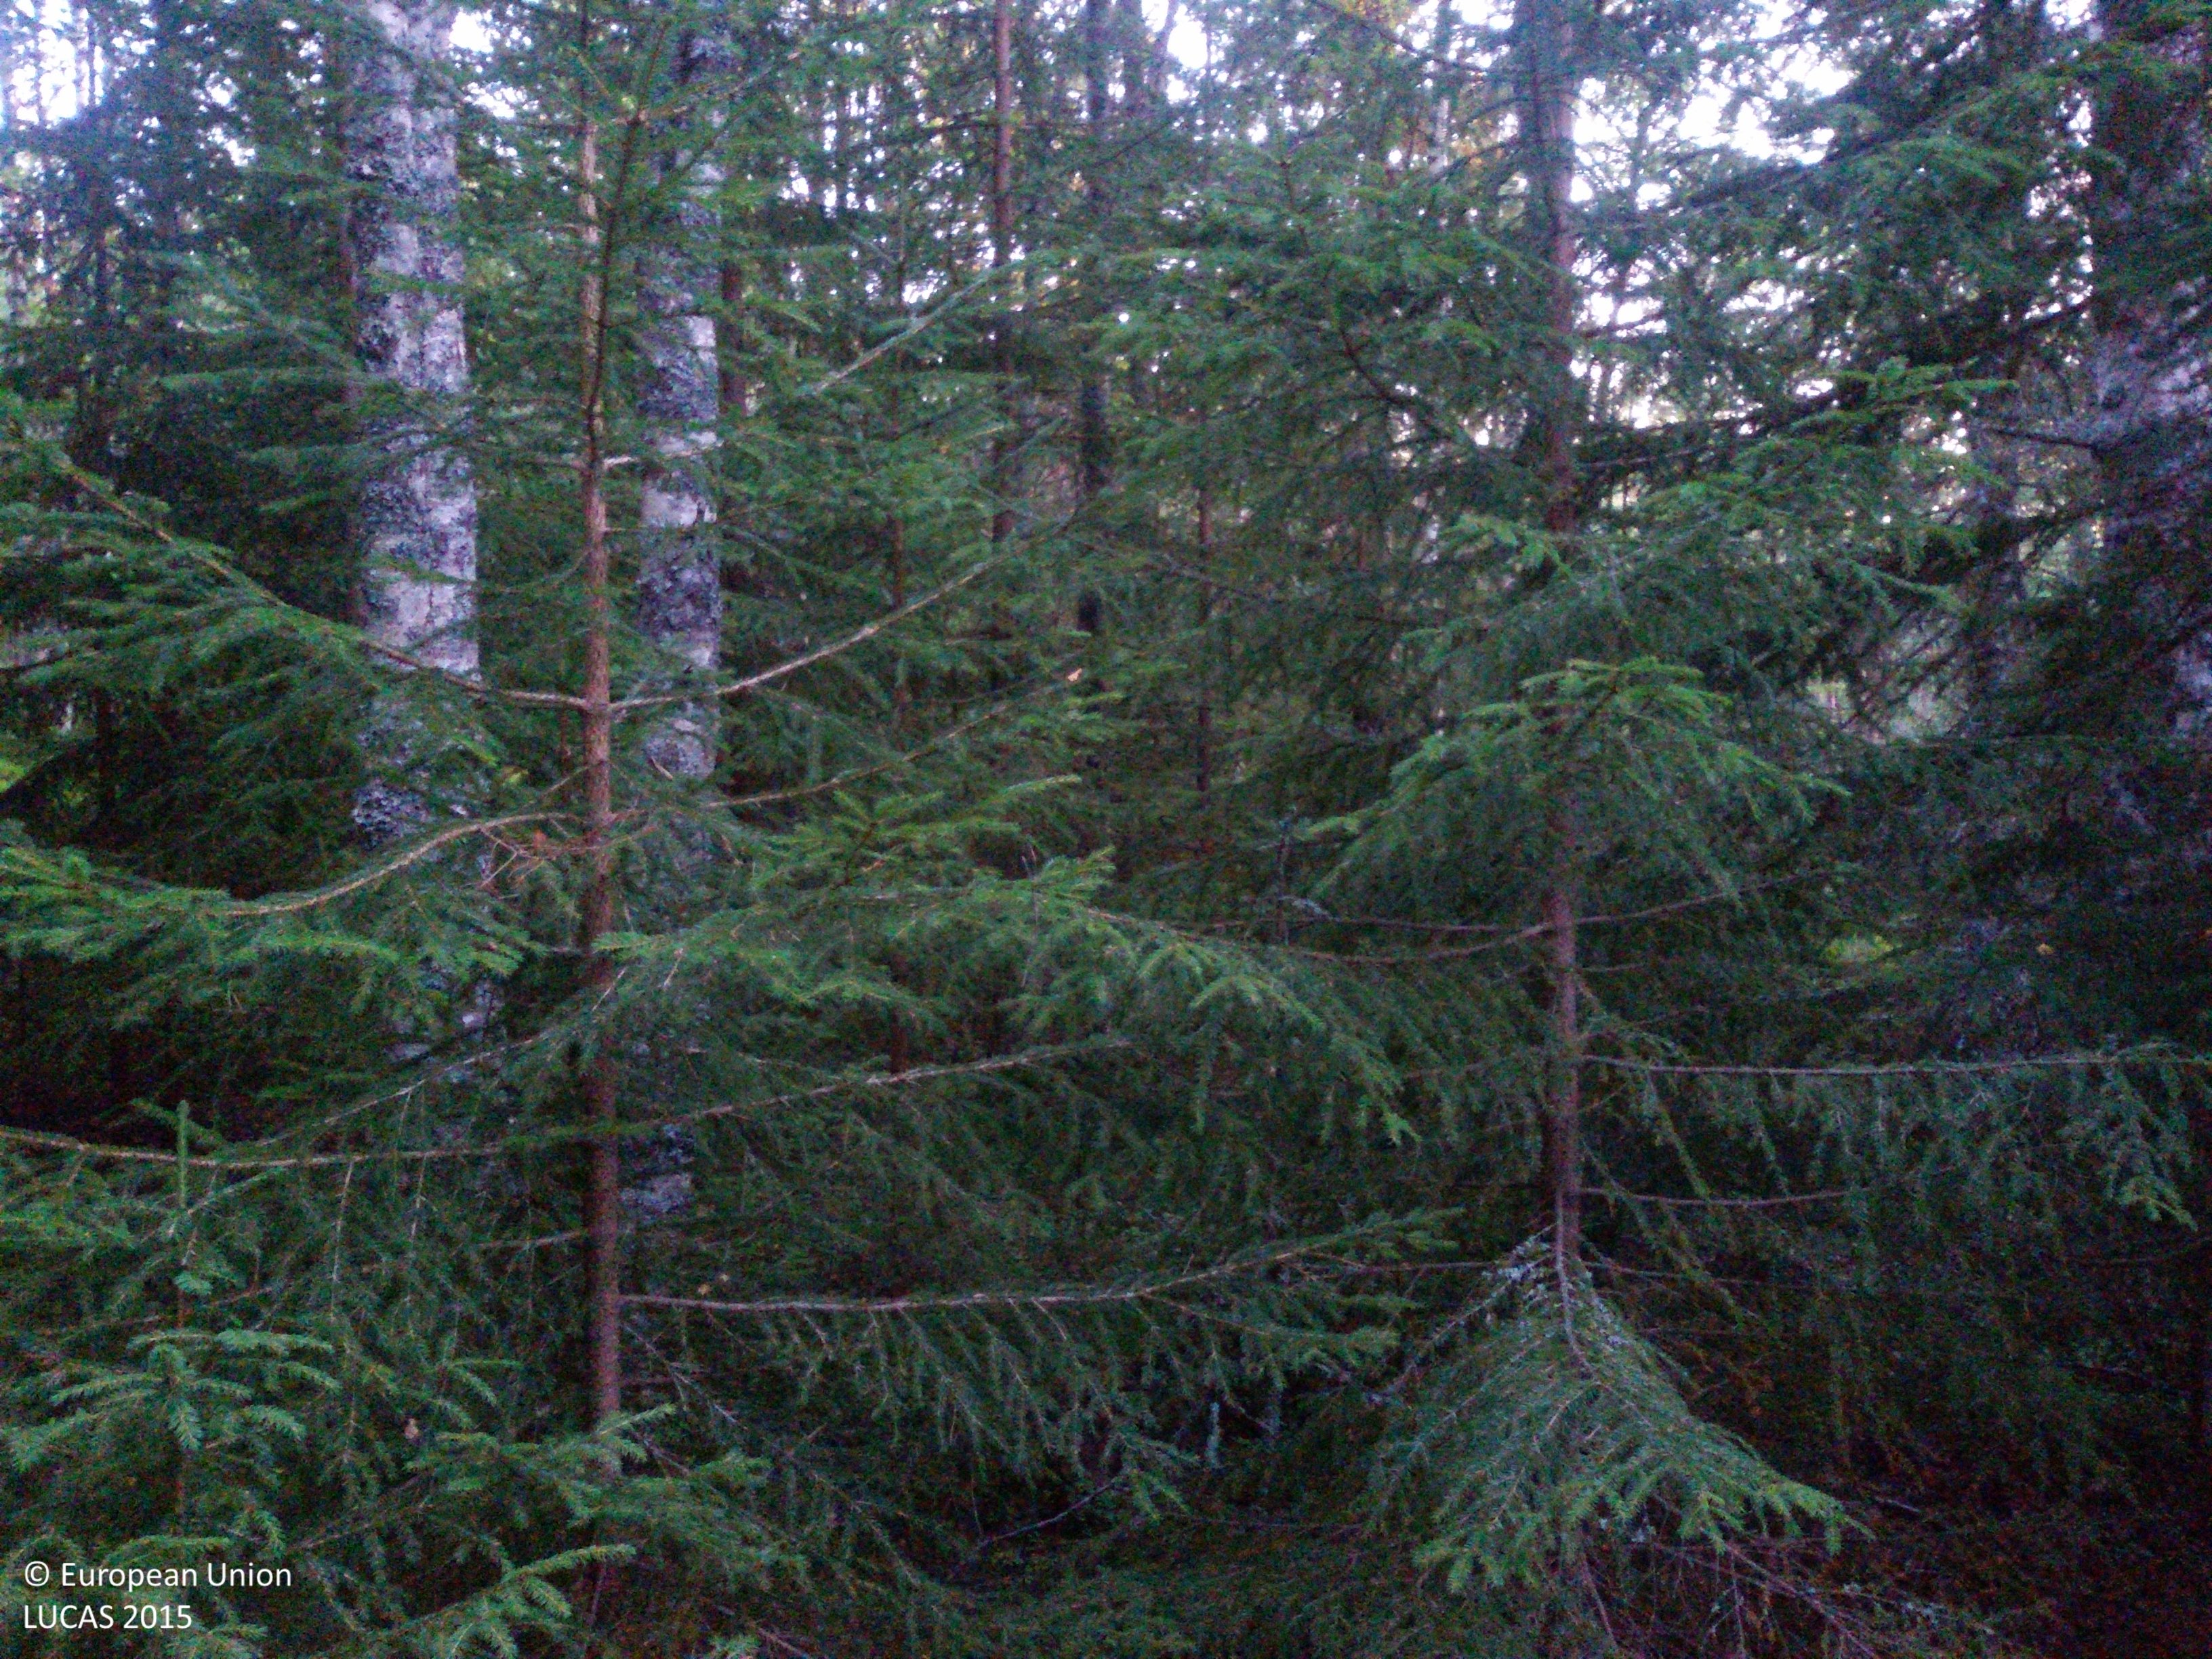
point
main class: Woodland
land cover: Spruce dominated mixed woodland
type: boreal forest
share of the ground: > 75 %
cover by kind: coniferous forest trees 40 %, broadleaved forest trees 40 %, shrubs 10 %, lichens and mosses 10 %
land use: Forestry
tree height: > 5 m
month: August
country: SE
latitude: 60.7618
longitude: 15.4378
